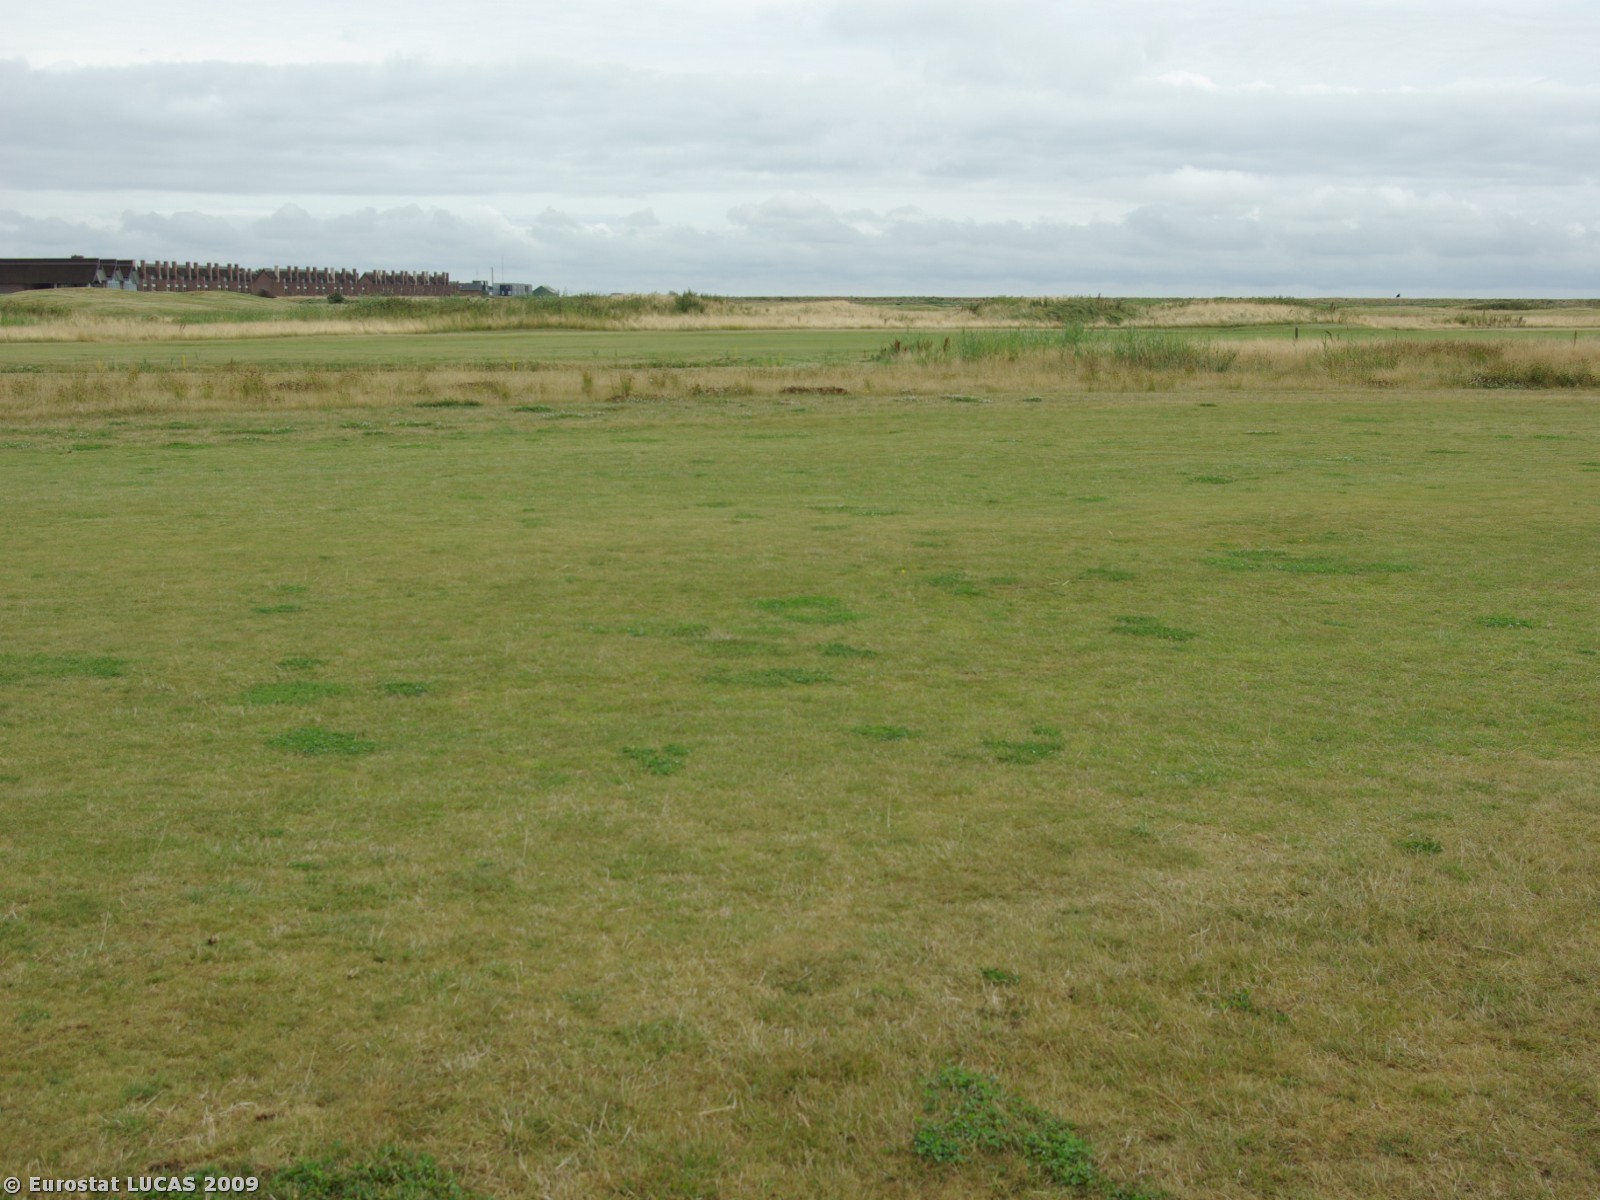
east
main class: Grassland
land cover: Grassland without tree/shrub cover
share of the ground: > 75 %
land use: Sport
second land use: Amenities, museums, leisure
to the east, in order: Grassland without tree/shrub cover; Grass margins; Ditches and canals; Grass margins; Grassland without tree/shrub cover; Spontaneously vegetated surfaces; Ditches and canals; Spontaneously vegetated surfaces; Grassland without tree/shrub cover
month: July
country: DK
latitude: 55.0829
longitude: 8.5442
